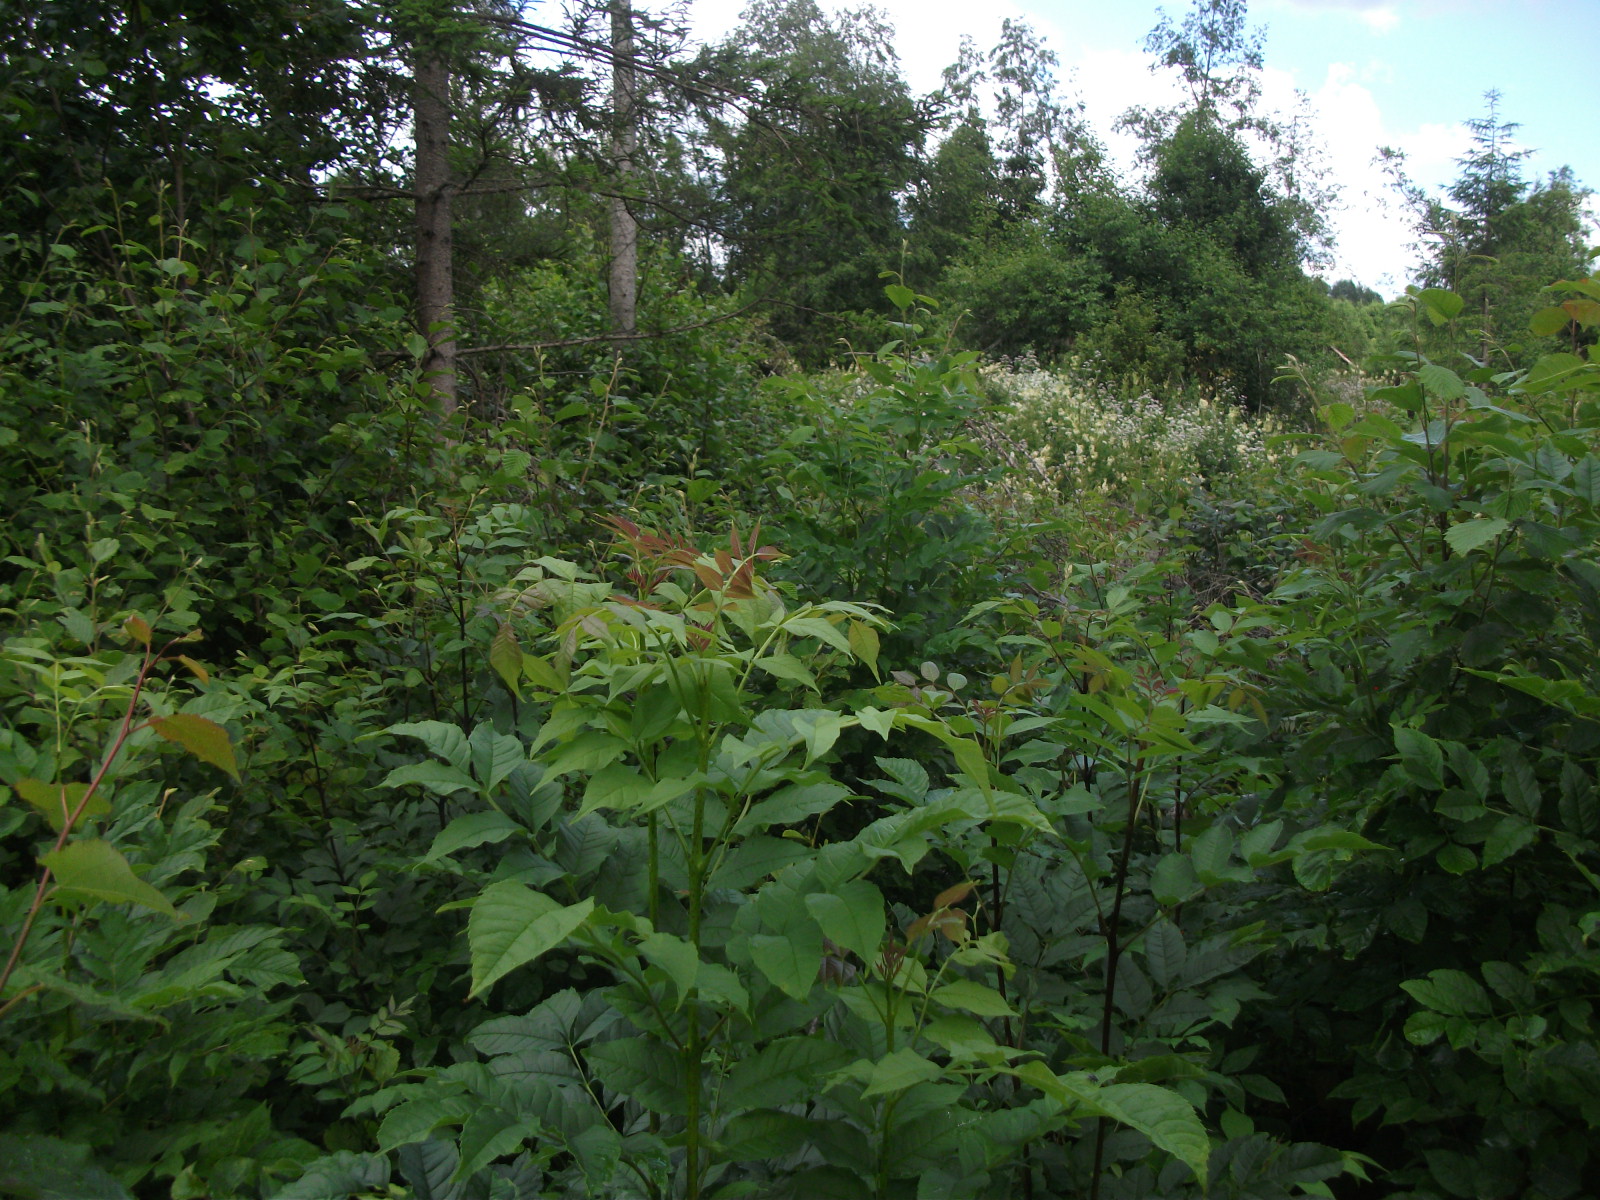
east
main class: Woodland
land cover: Broadleaved woodland
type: non-riverine alder, birch or aspen forest
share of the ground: 50 - 75 %
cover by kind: broadleaved forest trees 50 %, shrubs 40 %, herbaceous plants 10 %
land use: Forestry
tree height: < 5 m
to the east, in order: Broadleaved woodland; Ditches and canals; Spontaneously vegetated surfaces; Other bare soil; Shrubland without tree cover; Spontaneously vegetated surfaces; Shrubland without tree cover
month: July
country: LV
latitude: 56.9813
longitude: 26.2470
